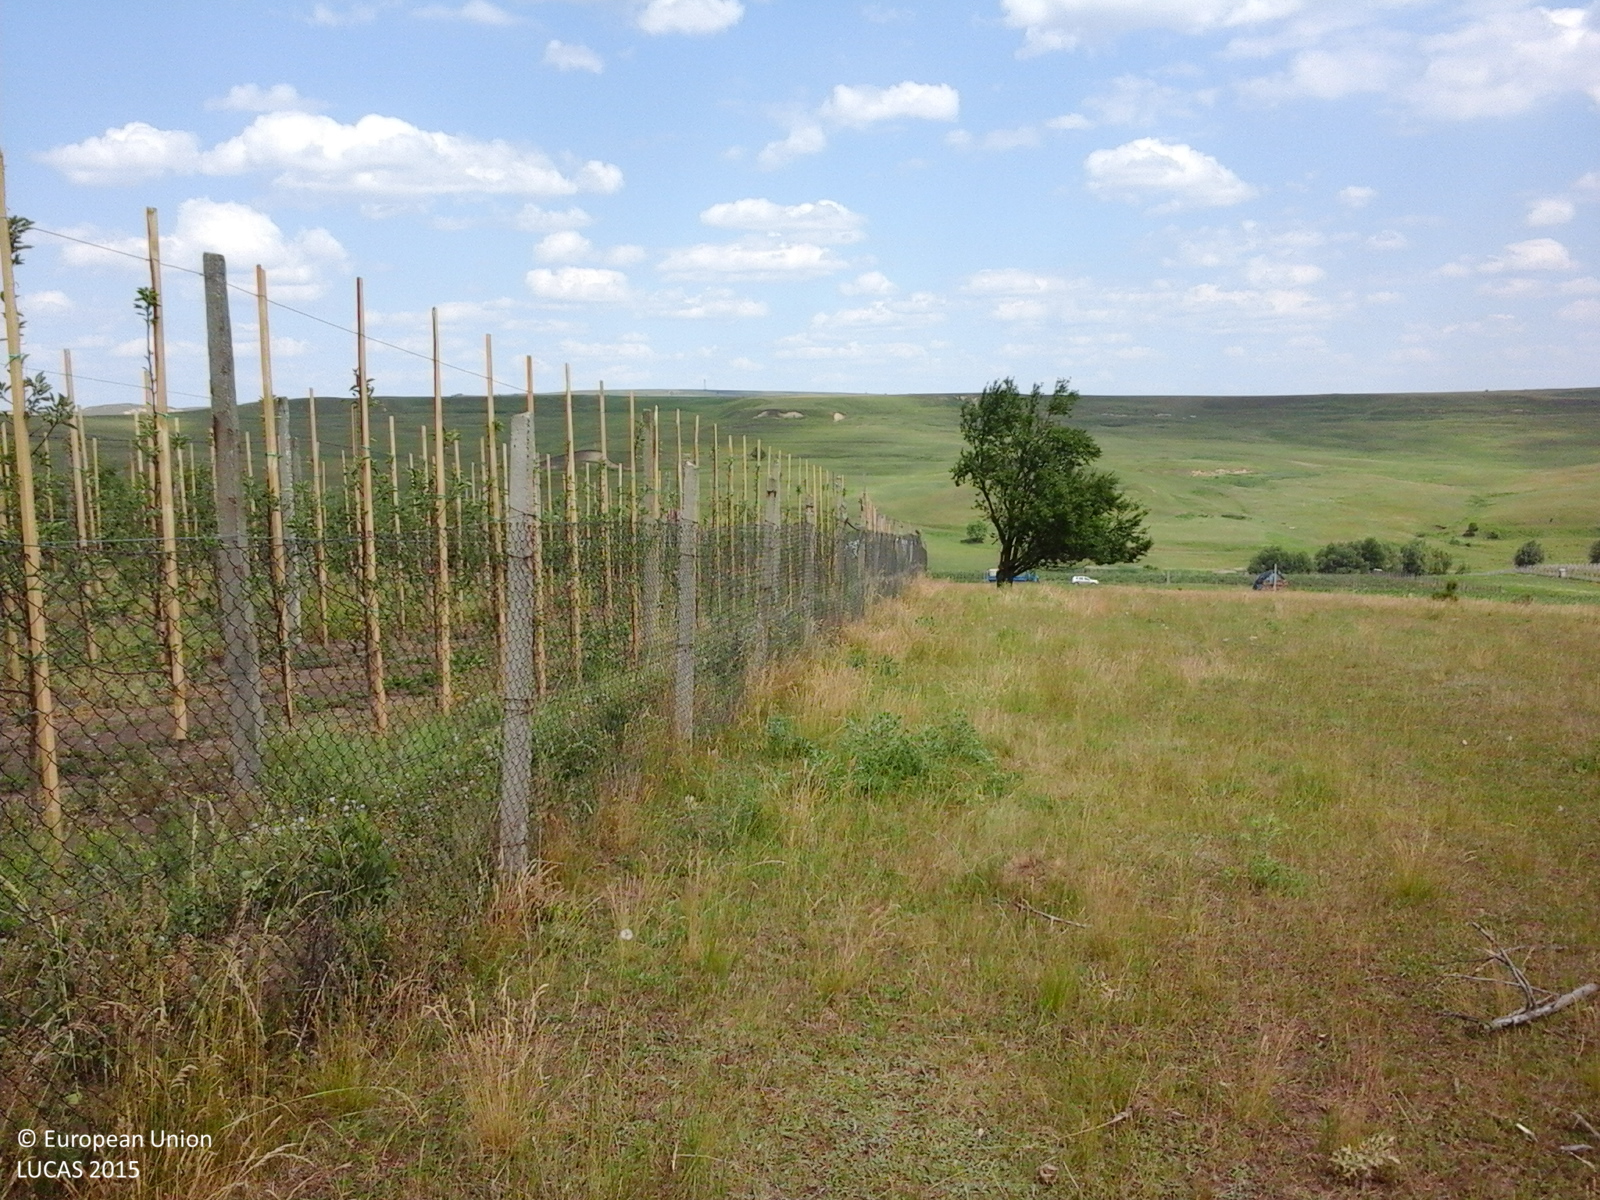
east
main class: Cropland
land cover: Apple fruit
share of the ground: 10 - 25 %
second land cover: Grassland without tree/shrub cover
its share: 50 - 75 %
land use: Agriculture (excluding fallow land and kitchen gardens)
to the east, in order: Apple fruit; Grassland without tree/shrub cover; Tracks; Apple fruit; Artificial constructions in urban areas
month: June
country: RO
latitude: 47.4964
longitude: 26.2911
